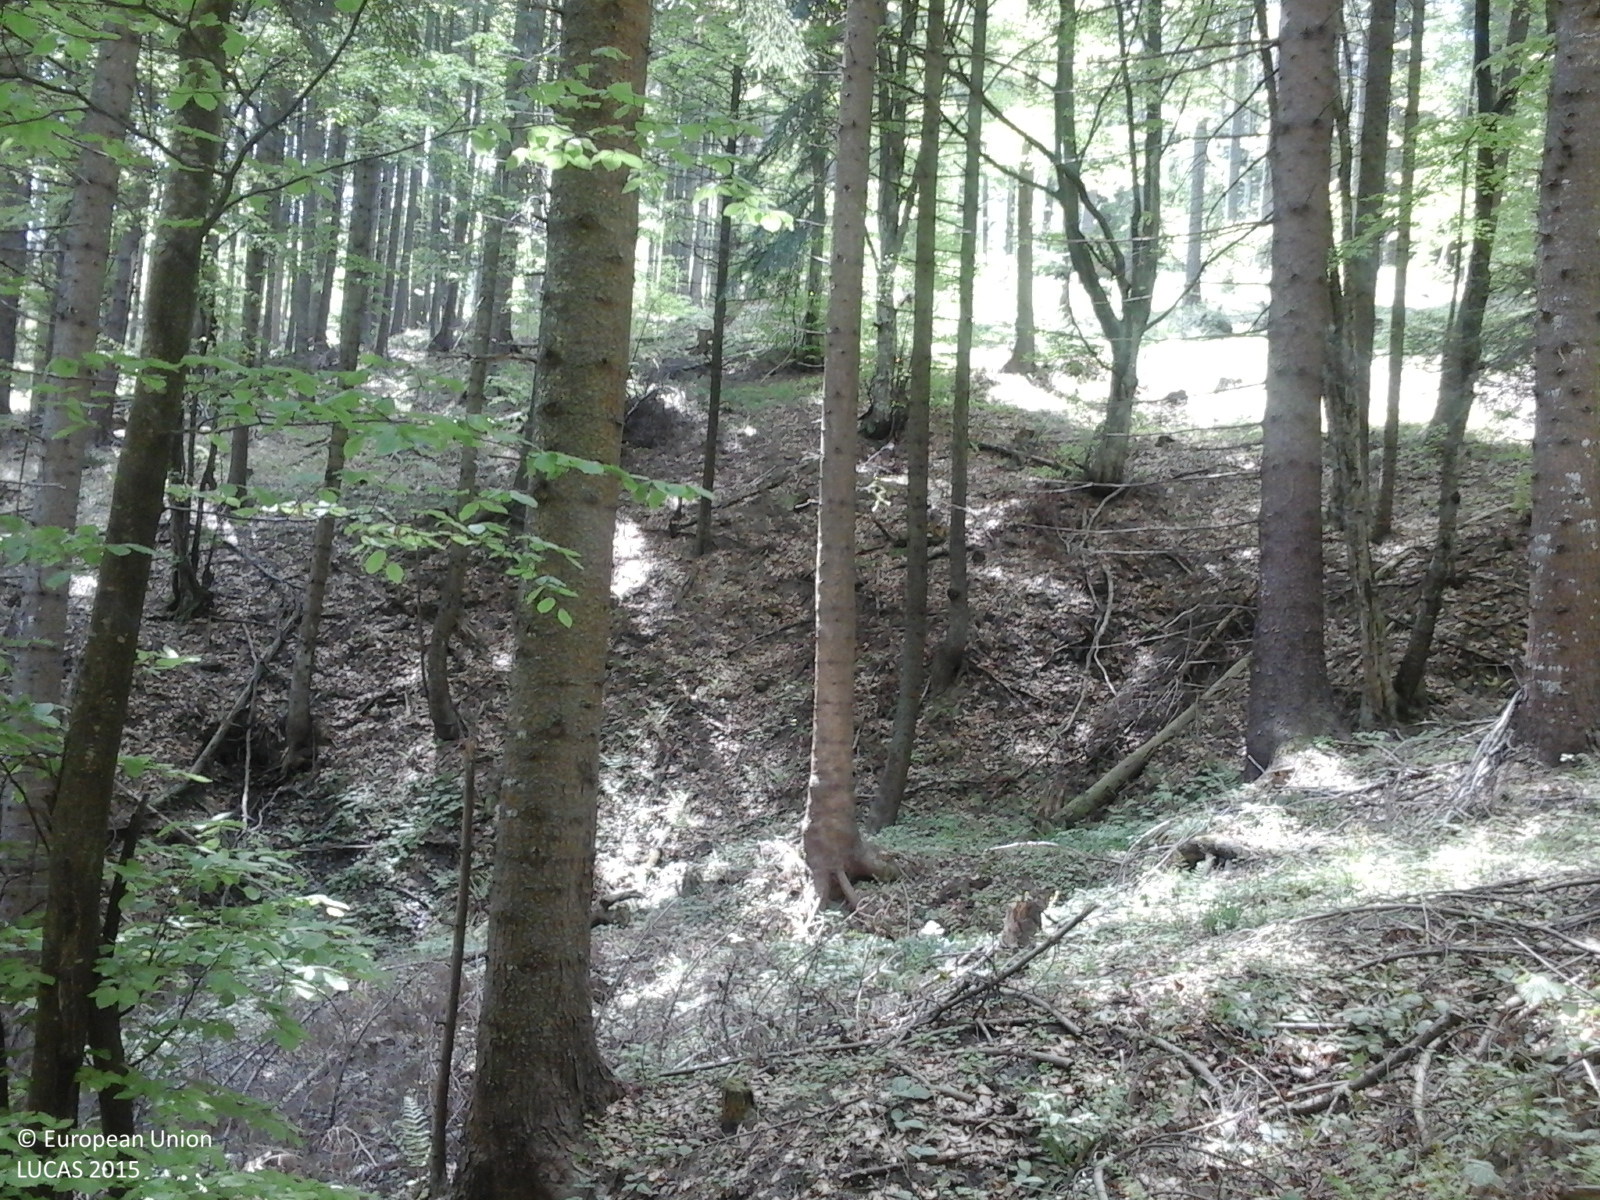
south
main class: Woodland
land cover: Spruce dominated mixed woodland
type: alpine coniferous forest
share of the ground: > 75 %
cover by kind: coniferous forest trees 75 %, broadleaved forest trees 25 %
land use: Forestry
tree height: > 5 m
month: May
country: RO
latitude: 45.9857
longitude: 26.3262
